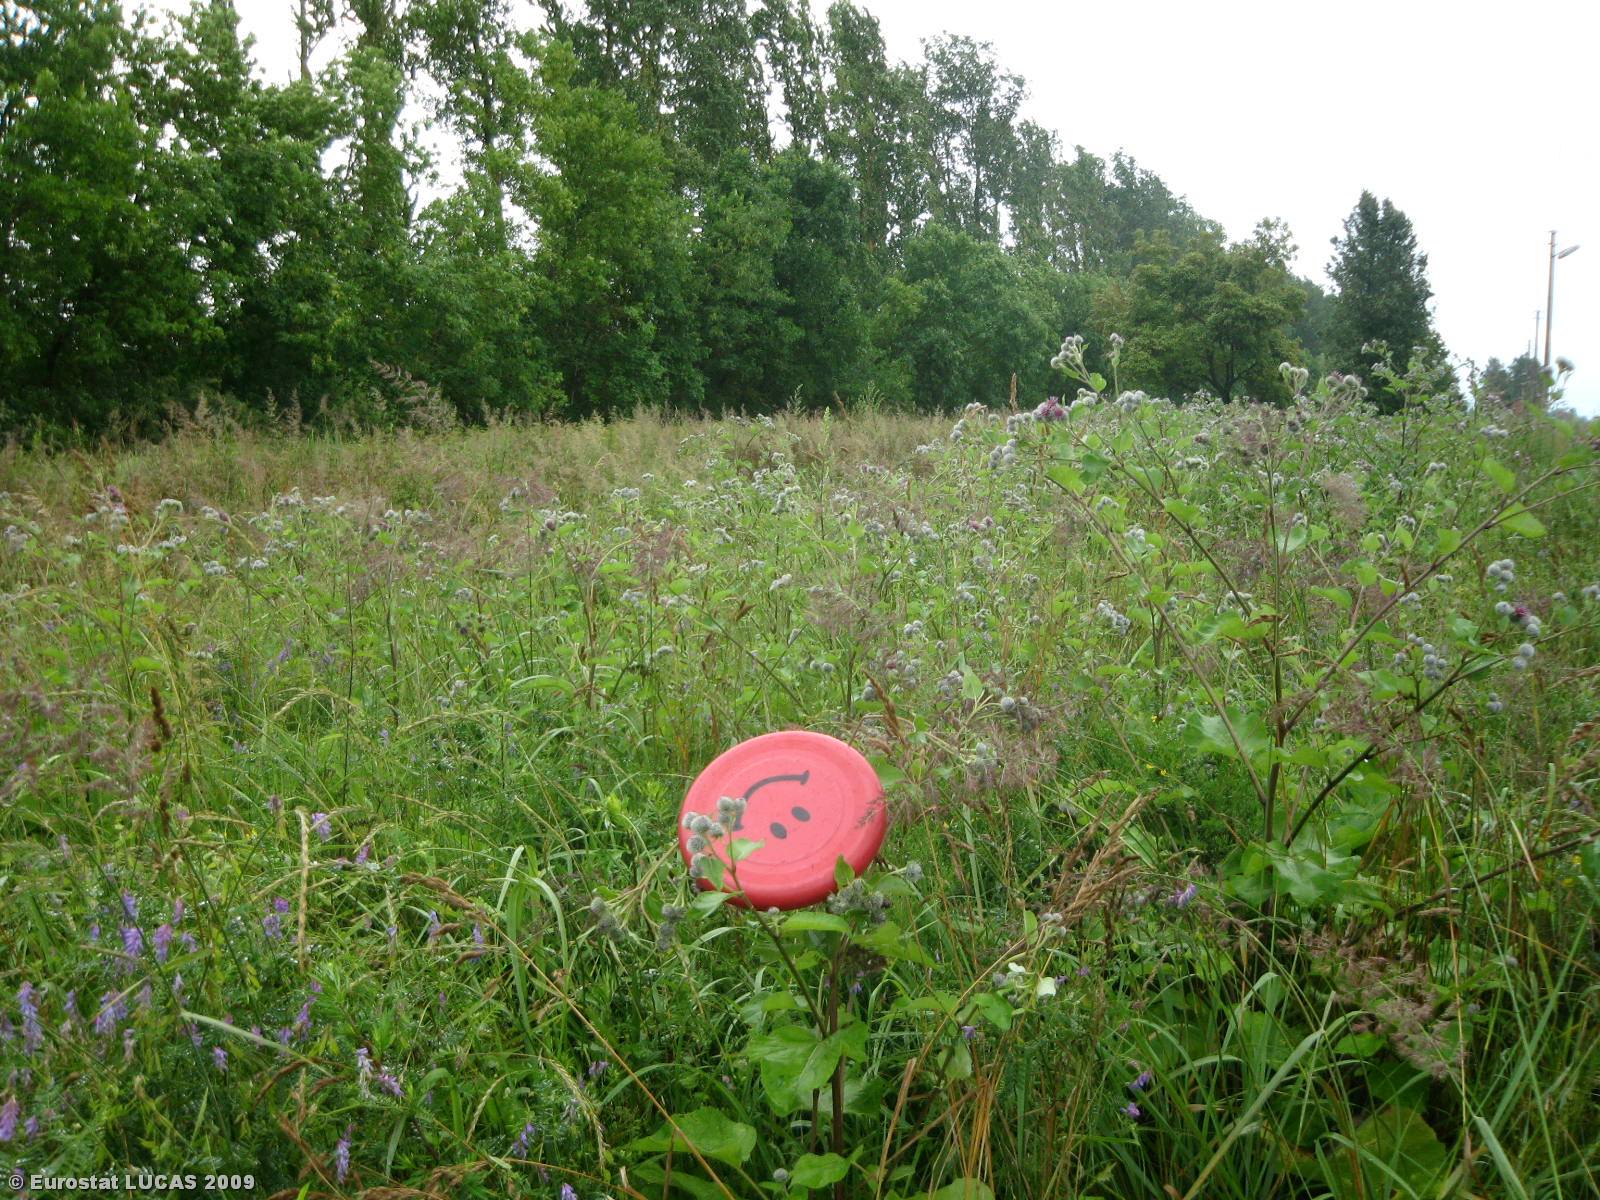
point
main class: Grassland
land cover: Grassland without tree/shrub cover
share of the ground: > 75 %
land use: Railway transport
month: July
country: LT
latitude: 55.5298
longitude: 23.7886
